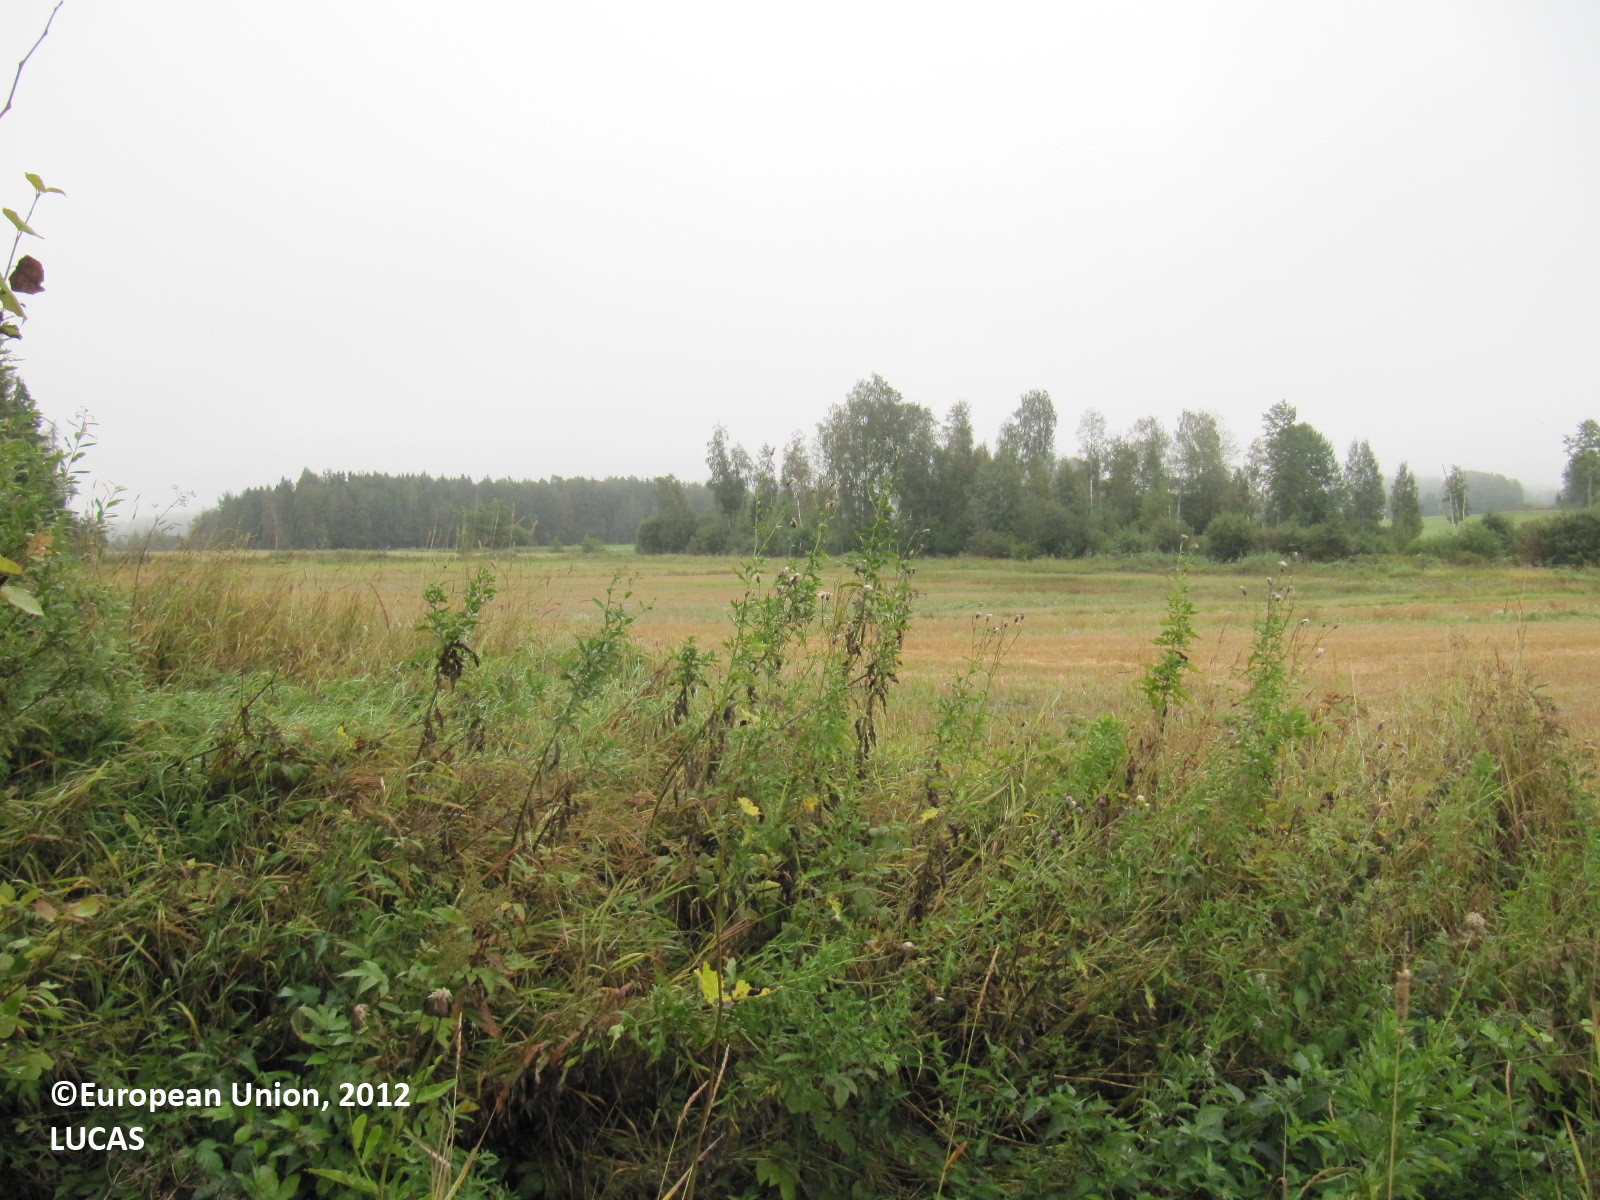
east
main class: Grassland
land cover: Spontaneously vegetated surfaces
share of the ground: > 75 %
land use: Agriculture (excluding fallow land and kitchen gardens)
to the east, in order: Ditches and canals; Grass margins; Rye; Ditches and canals; Rye; Ditches and canals; Rye; Spontaneously vegetated surfaces; Inland running water; Broadleaved woodland
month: August
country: FI
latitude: 60.1986
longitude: 24.3005
